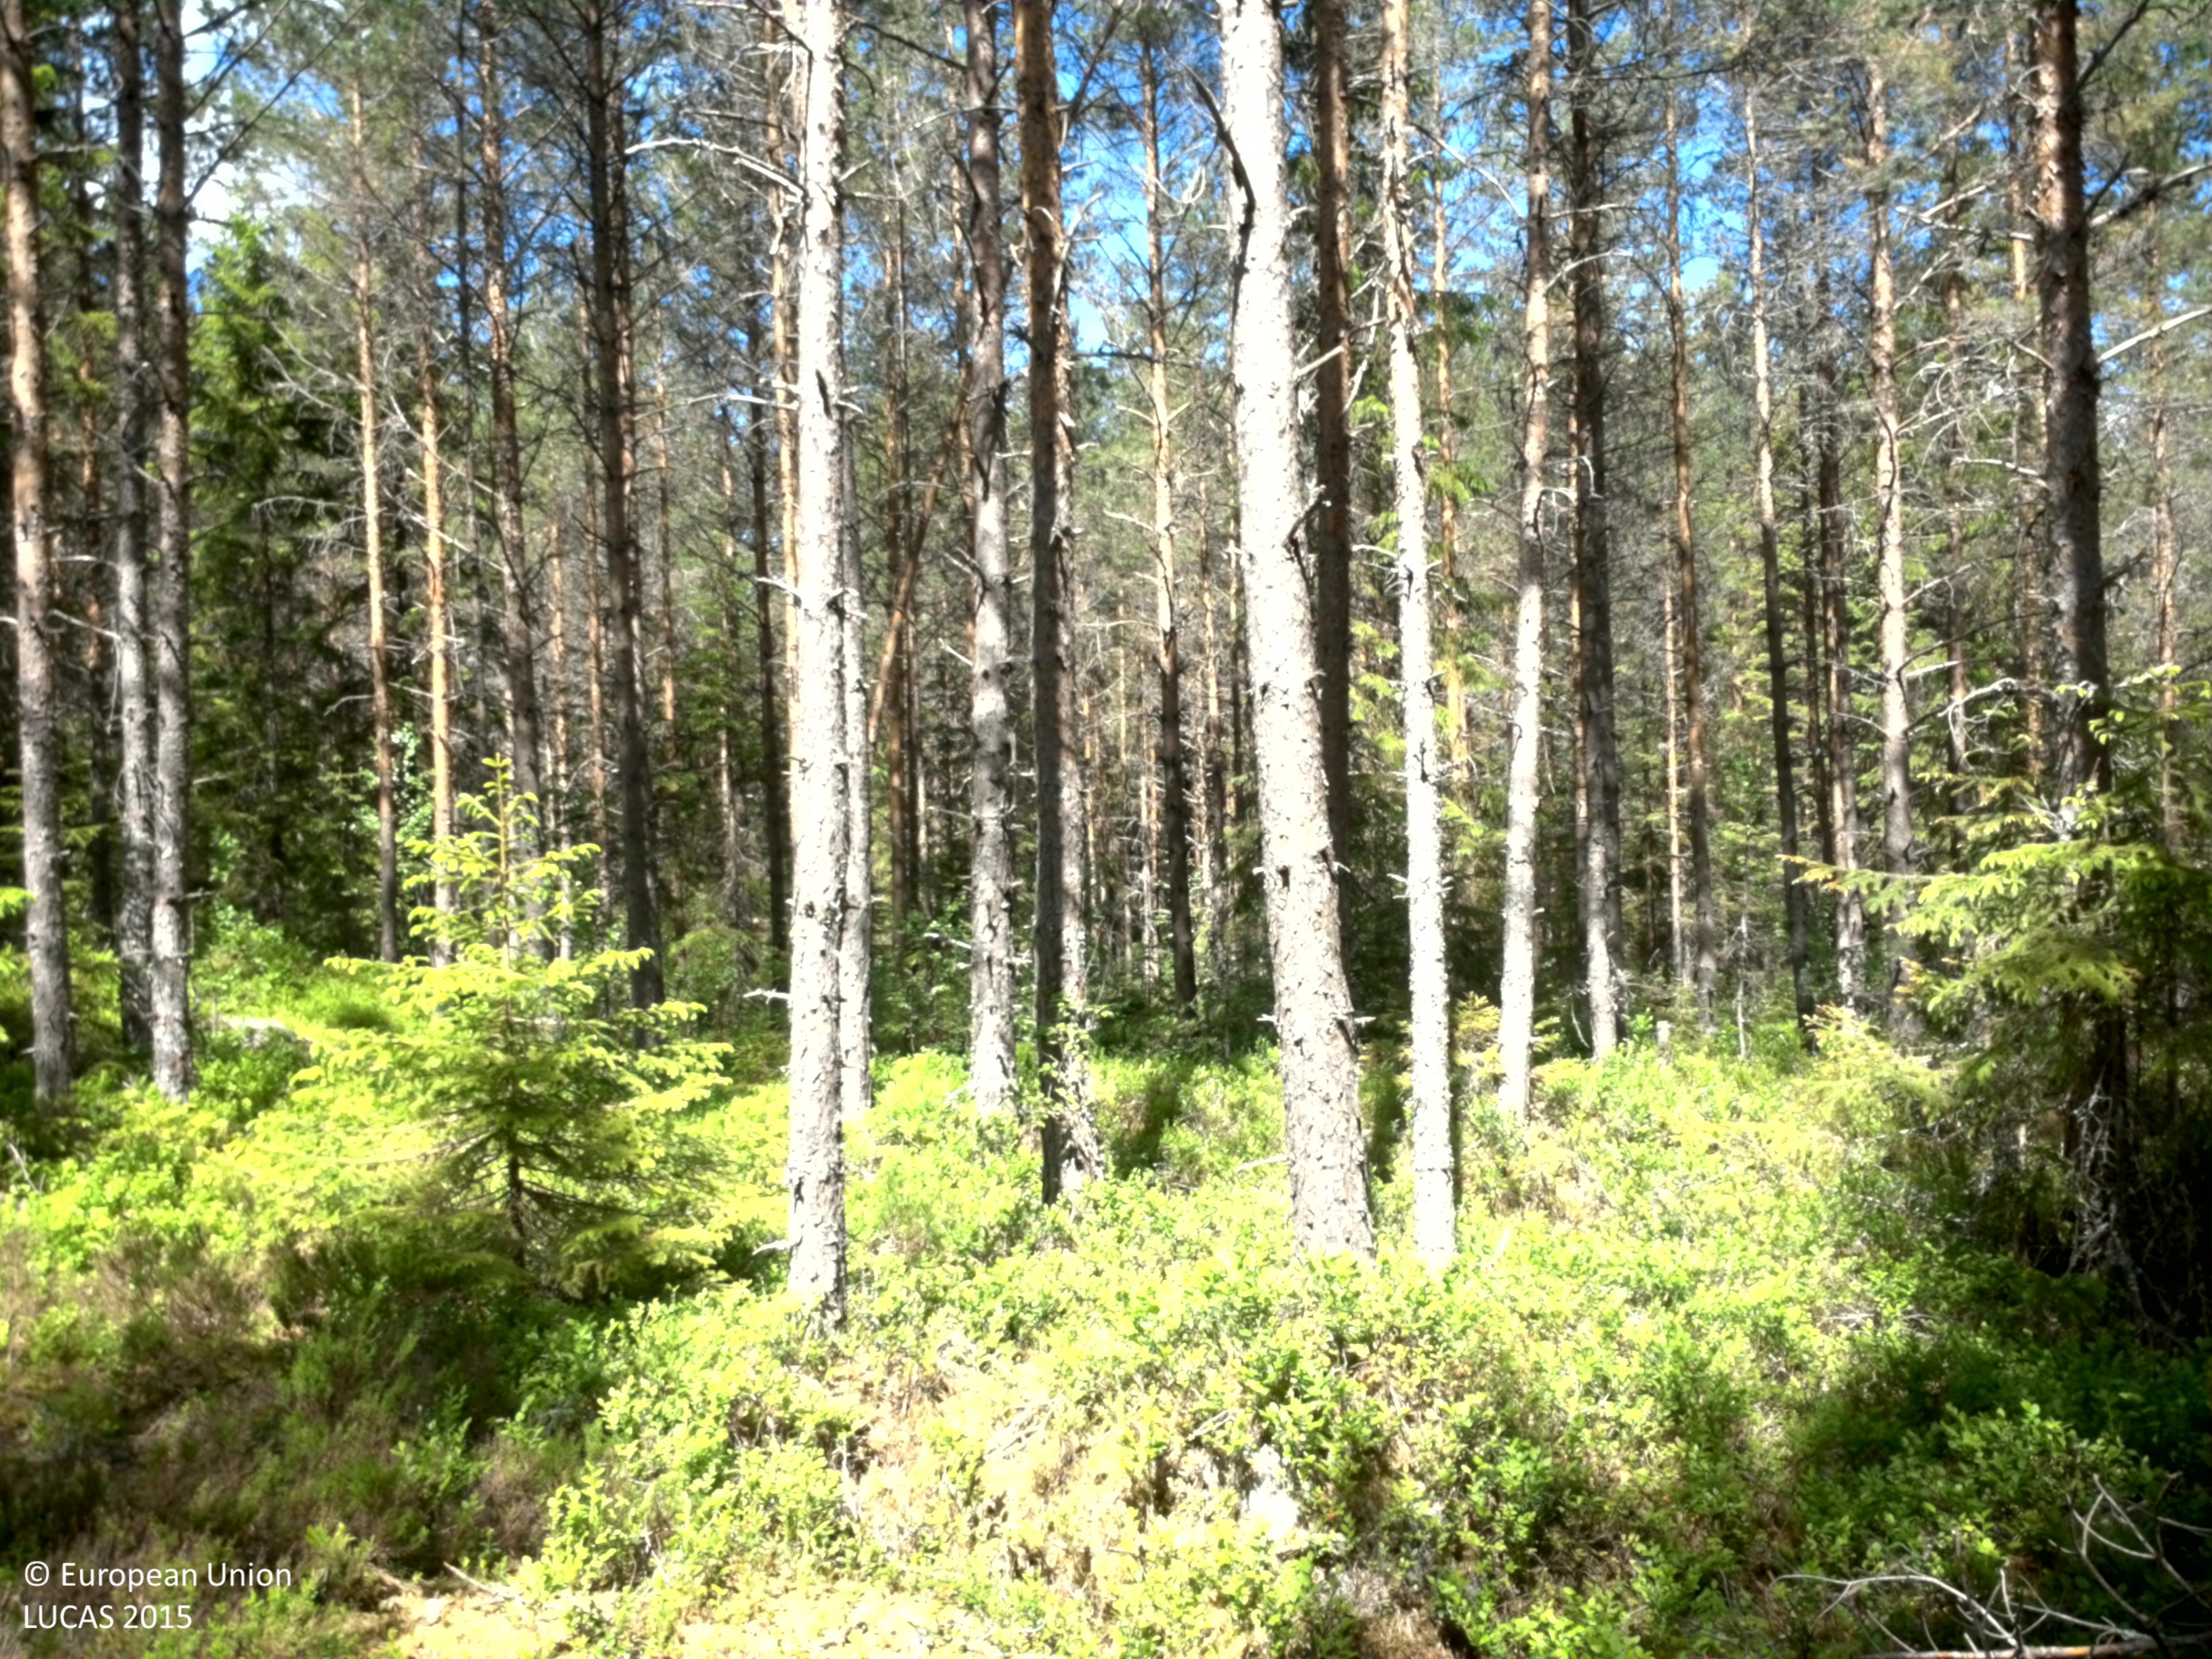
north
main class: Woodland
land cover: Pine dominated coniferous woodland
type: boreal forest
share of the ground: > 75 %
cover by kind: coniferous forest trees 75 %, shrubs 15 %, broadleaved forest trees 5 %, herbaceous plants 5 %
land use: Forestry
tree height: > 5 m
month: June
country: SE
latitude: 59.5893
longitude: 12.0667
